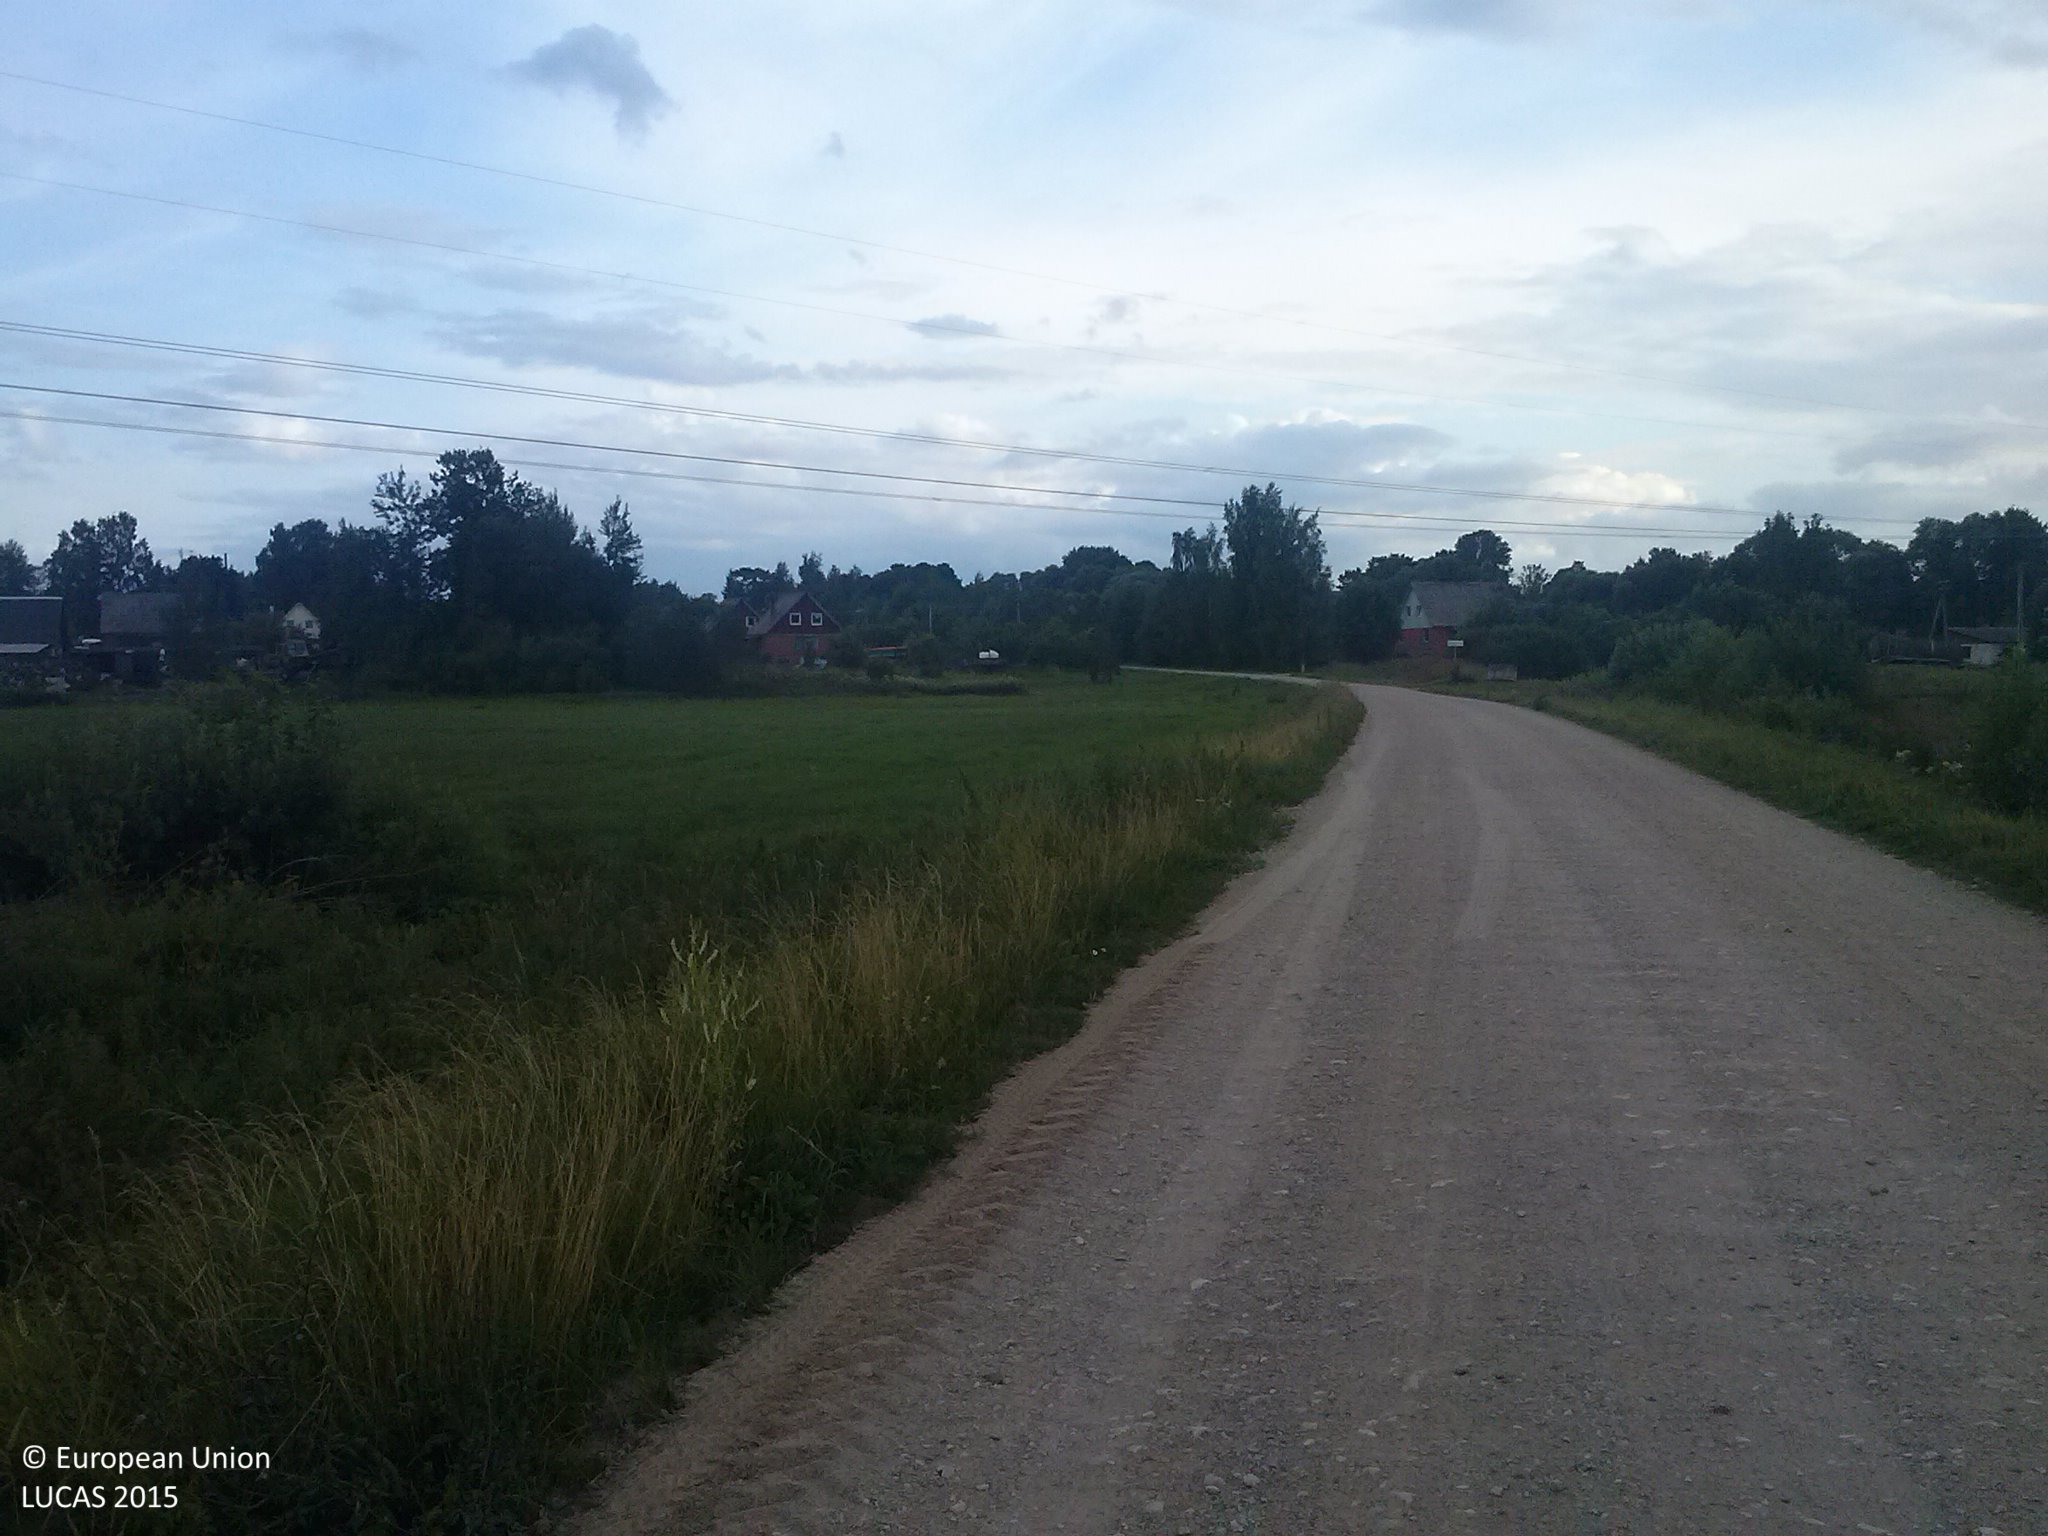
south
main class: Grassland
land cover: Grassland without tree/shrub cover
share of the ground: > 75 %
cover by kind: herbaceous plants 100 %
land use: Agriculture (excluding fallow land and kitchen gardens)
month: July
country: LV
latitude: 56.7176
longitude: 27.4130
